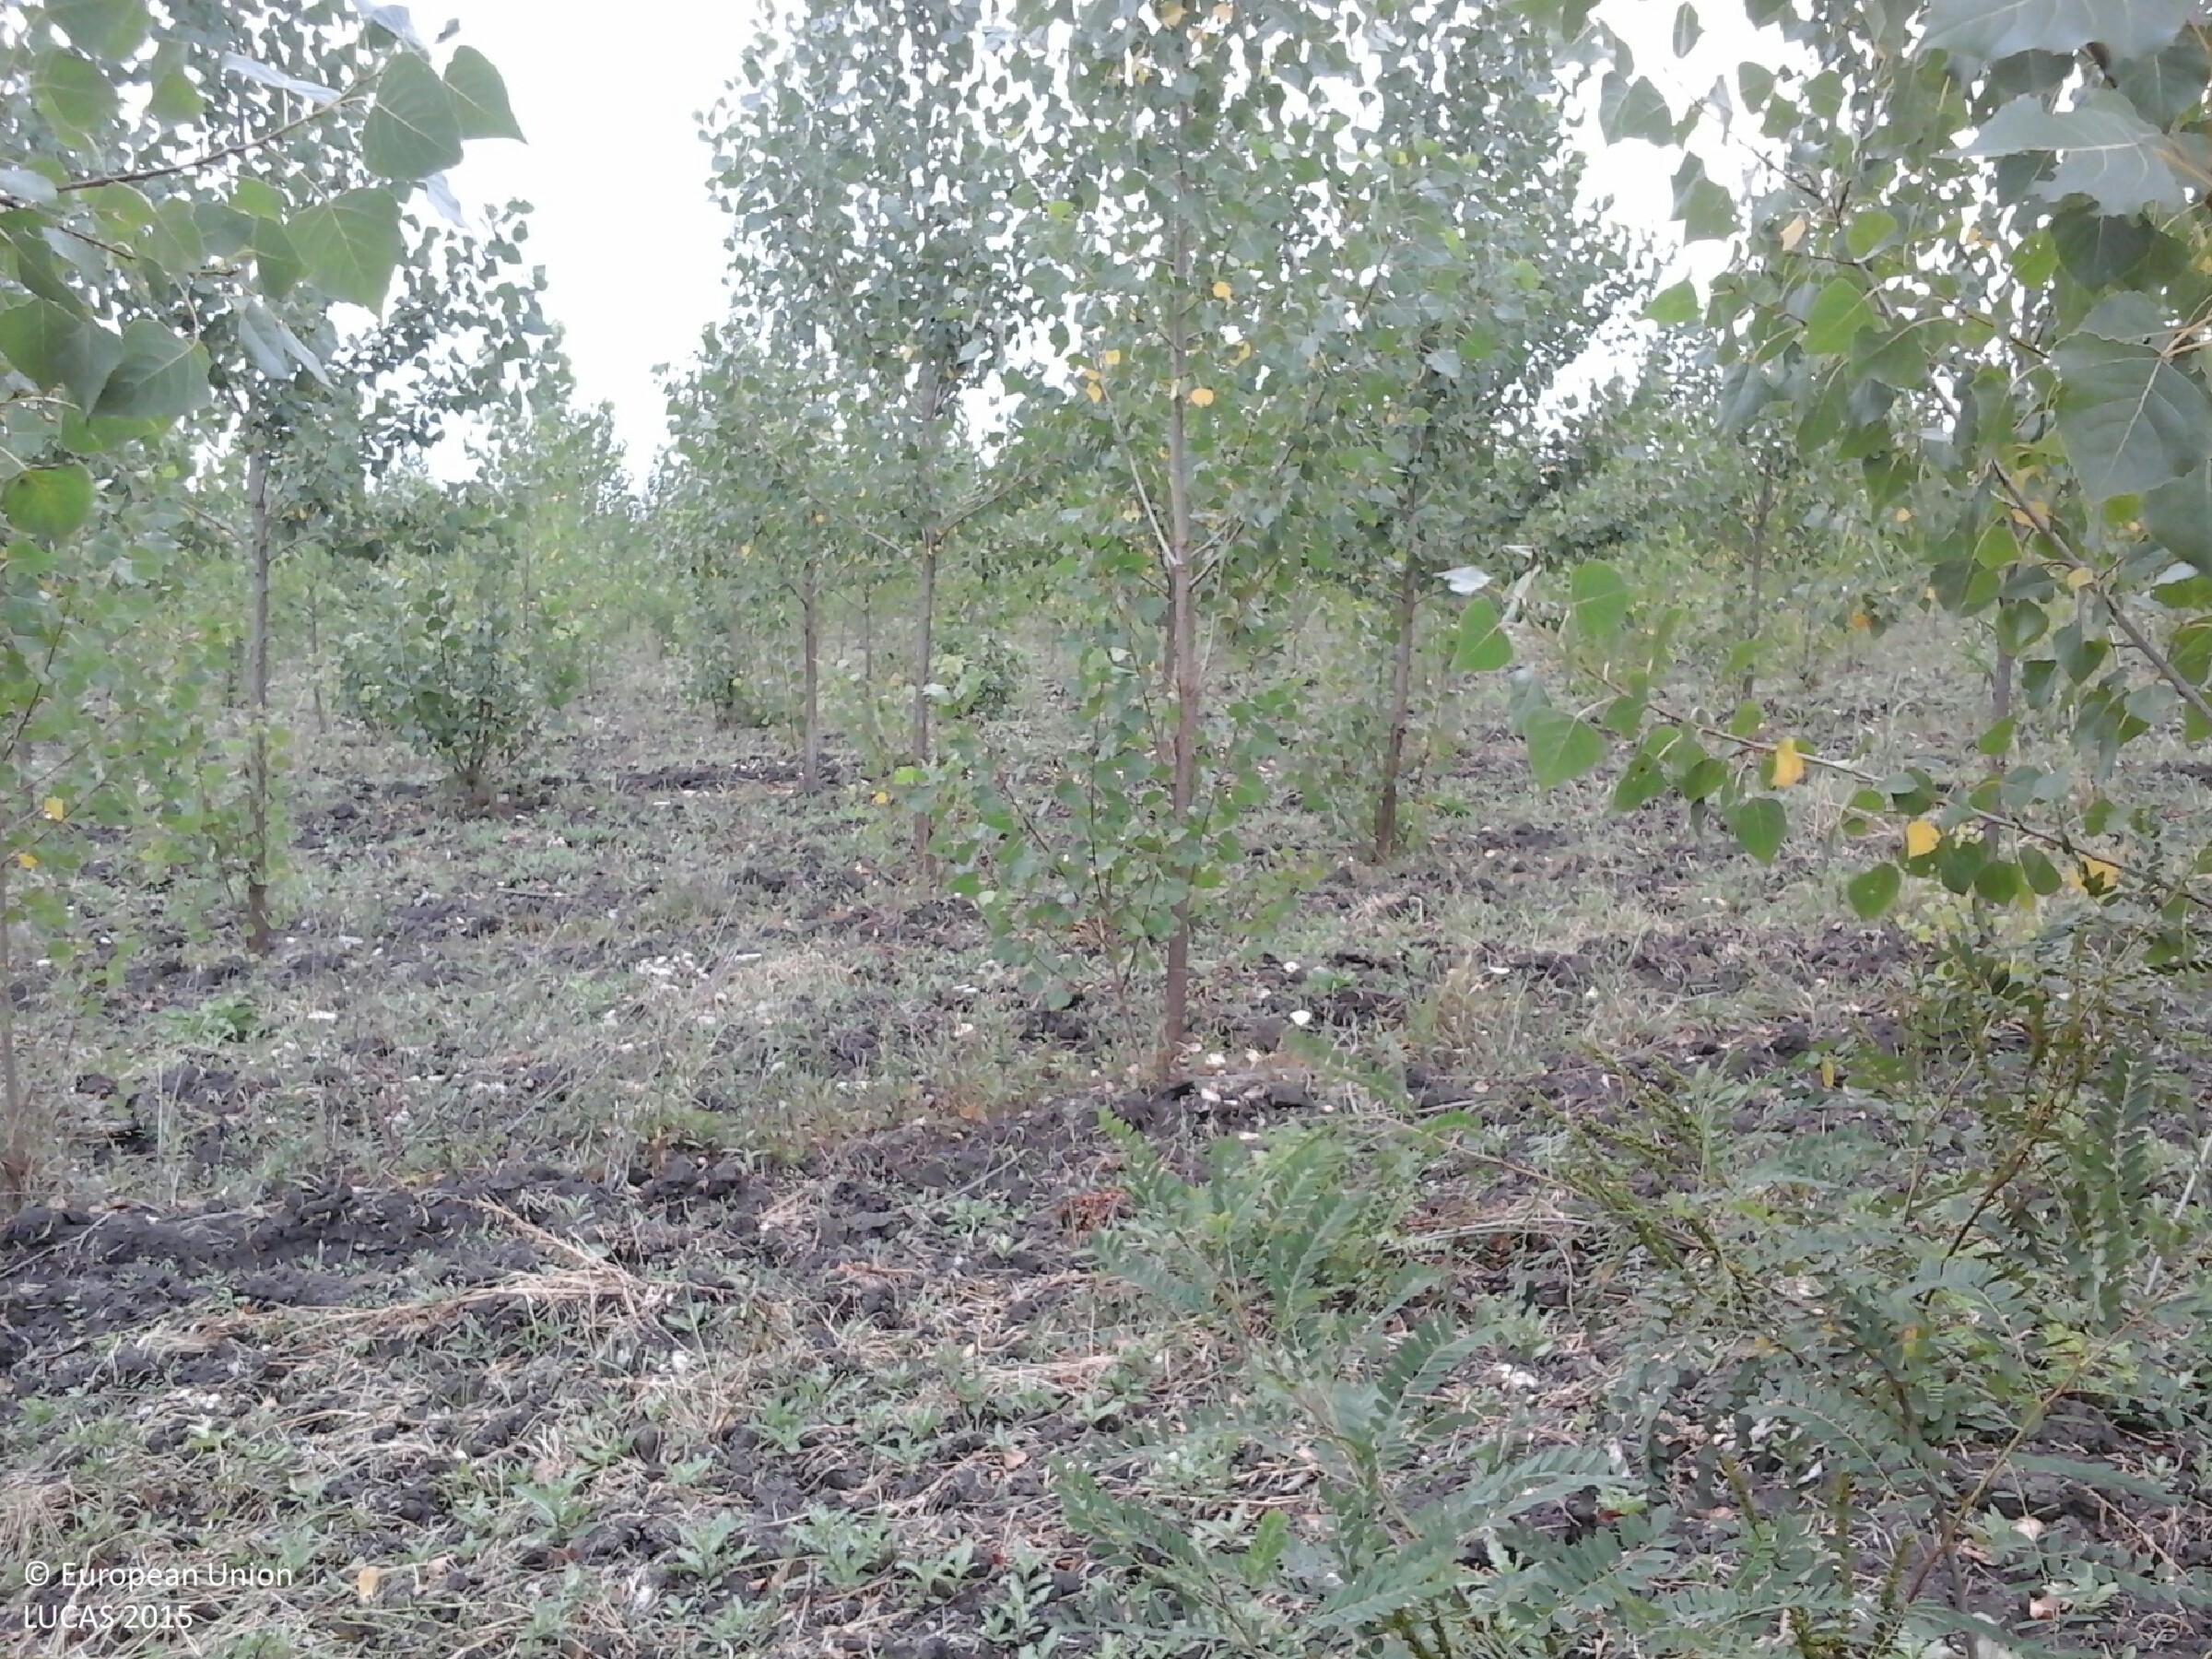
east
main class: Woodland
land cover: Broadleaved woodland
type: non-riverine alder, birch or aspen forest
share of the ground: 50 - 75 %
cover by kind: broadleaved forest trees 50 %, unconsolidated bare surface 35 %, herbaceous plants 15 %
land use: Forestry
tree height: < 5 m
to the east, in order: Broadleaved woodland; Shrubland with sparse tree cover; Grassland with sparse tree/shrub cover; Spontaneously vegetated surfaces
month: July
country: HU
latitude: 47.4617
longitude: 20.5510
